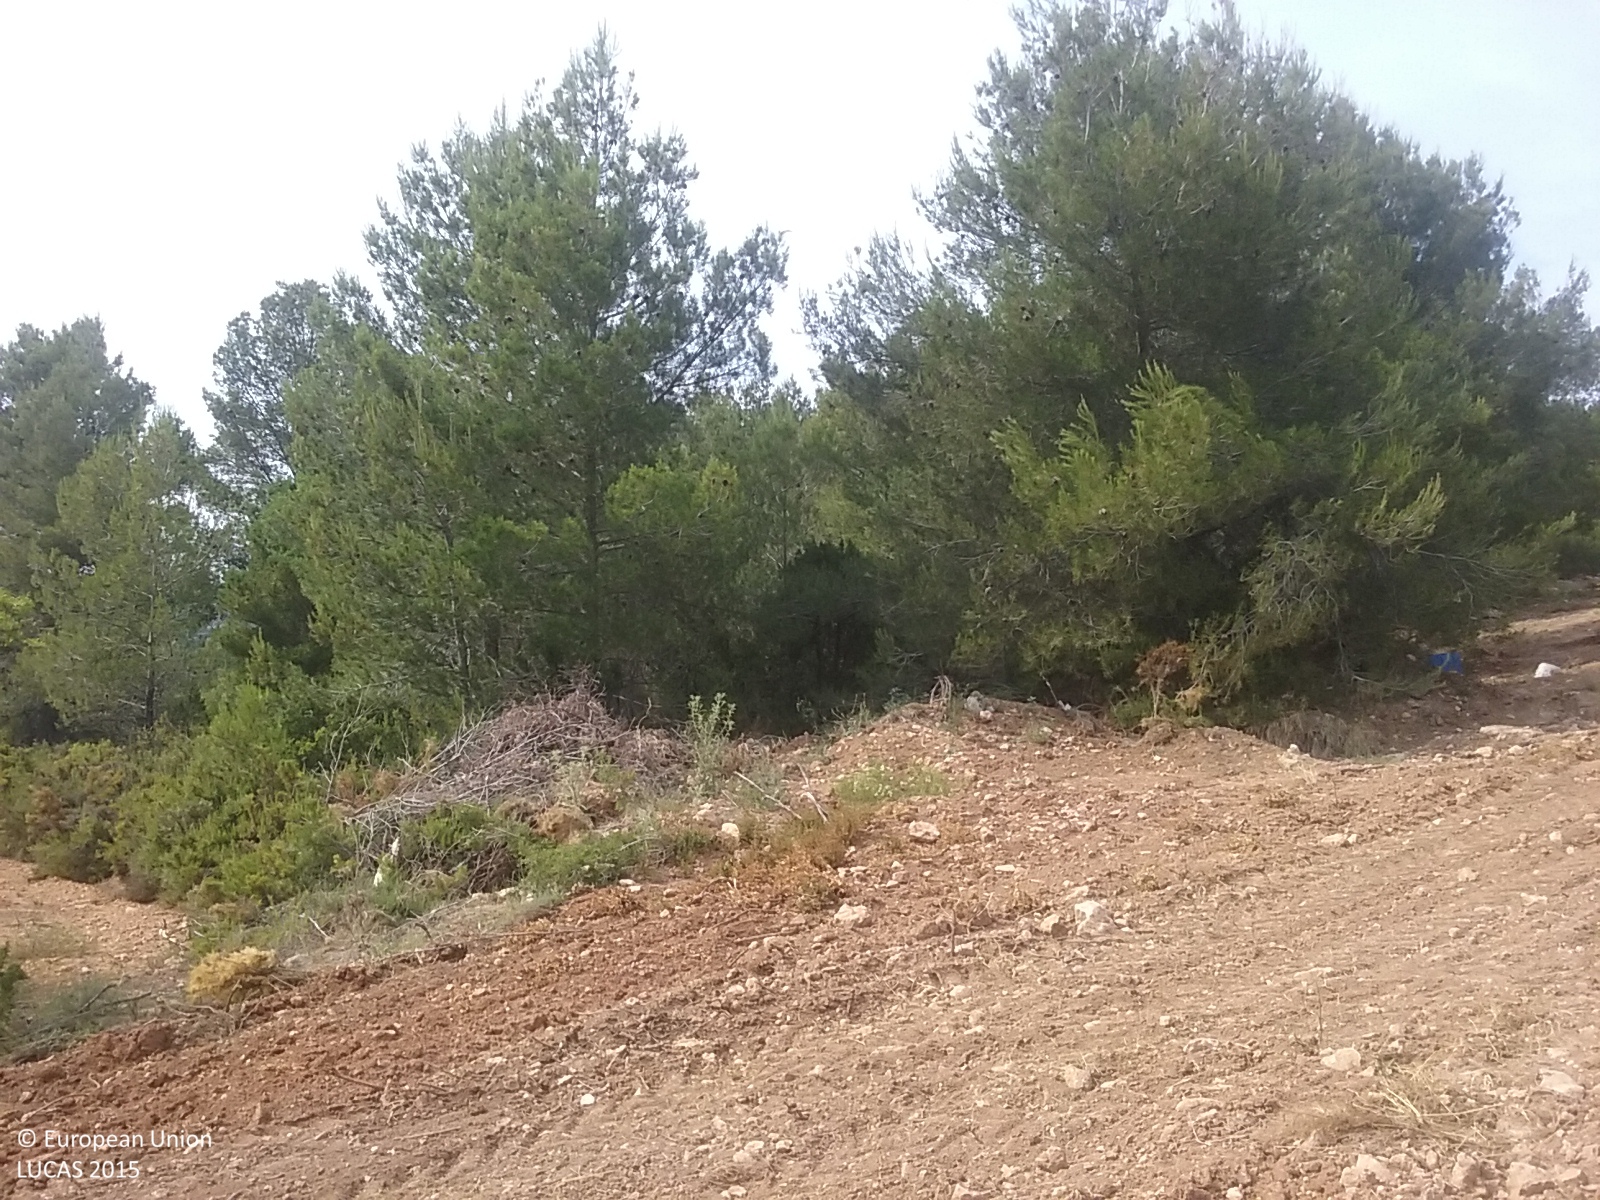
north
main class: Cropland
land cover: Nuts trees
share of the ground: 10 - 25 %
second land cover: Spontaneously vegetated surfaces
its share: 10 - 25 %
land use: Agriculture (excluding fallow land and kitchen gardens)
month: July
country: ES
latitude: 39.9166
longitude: -0.7083
